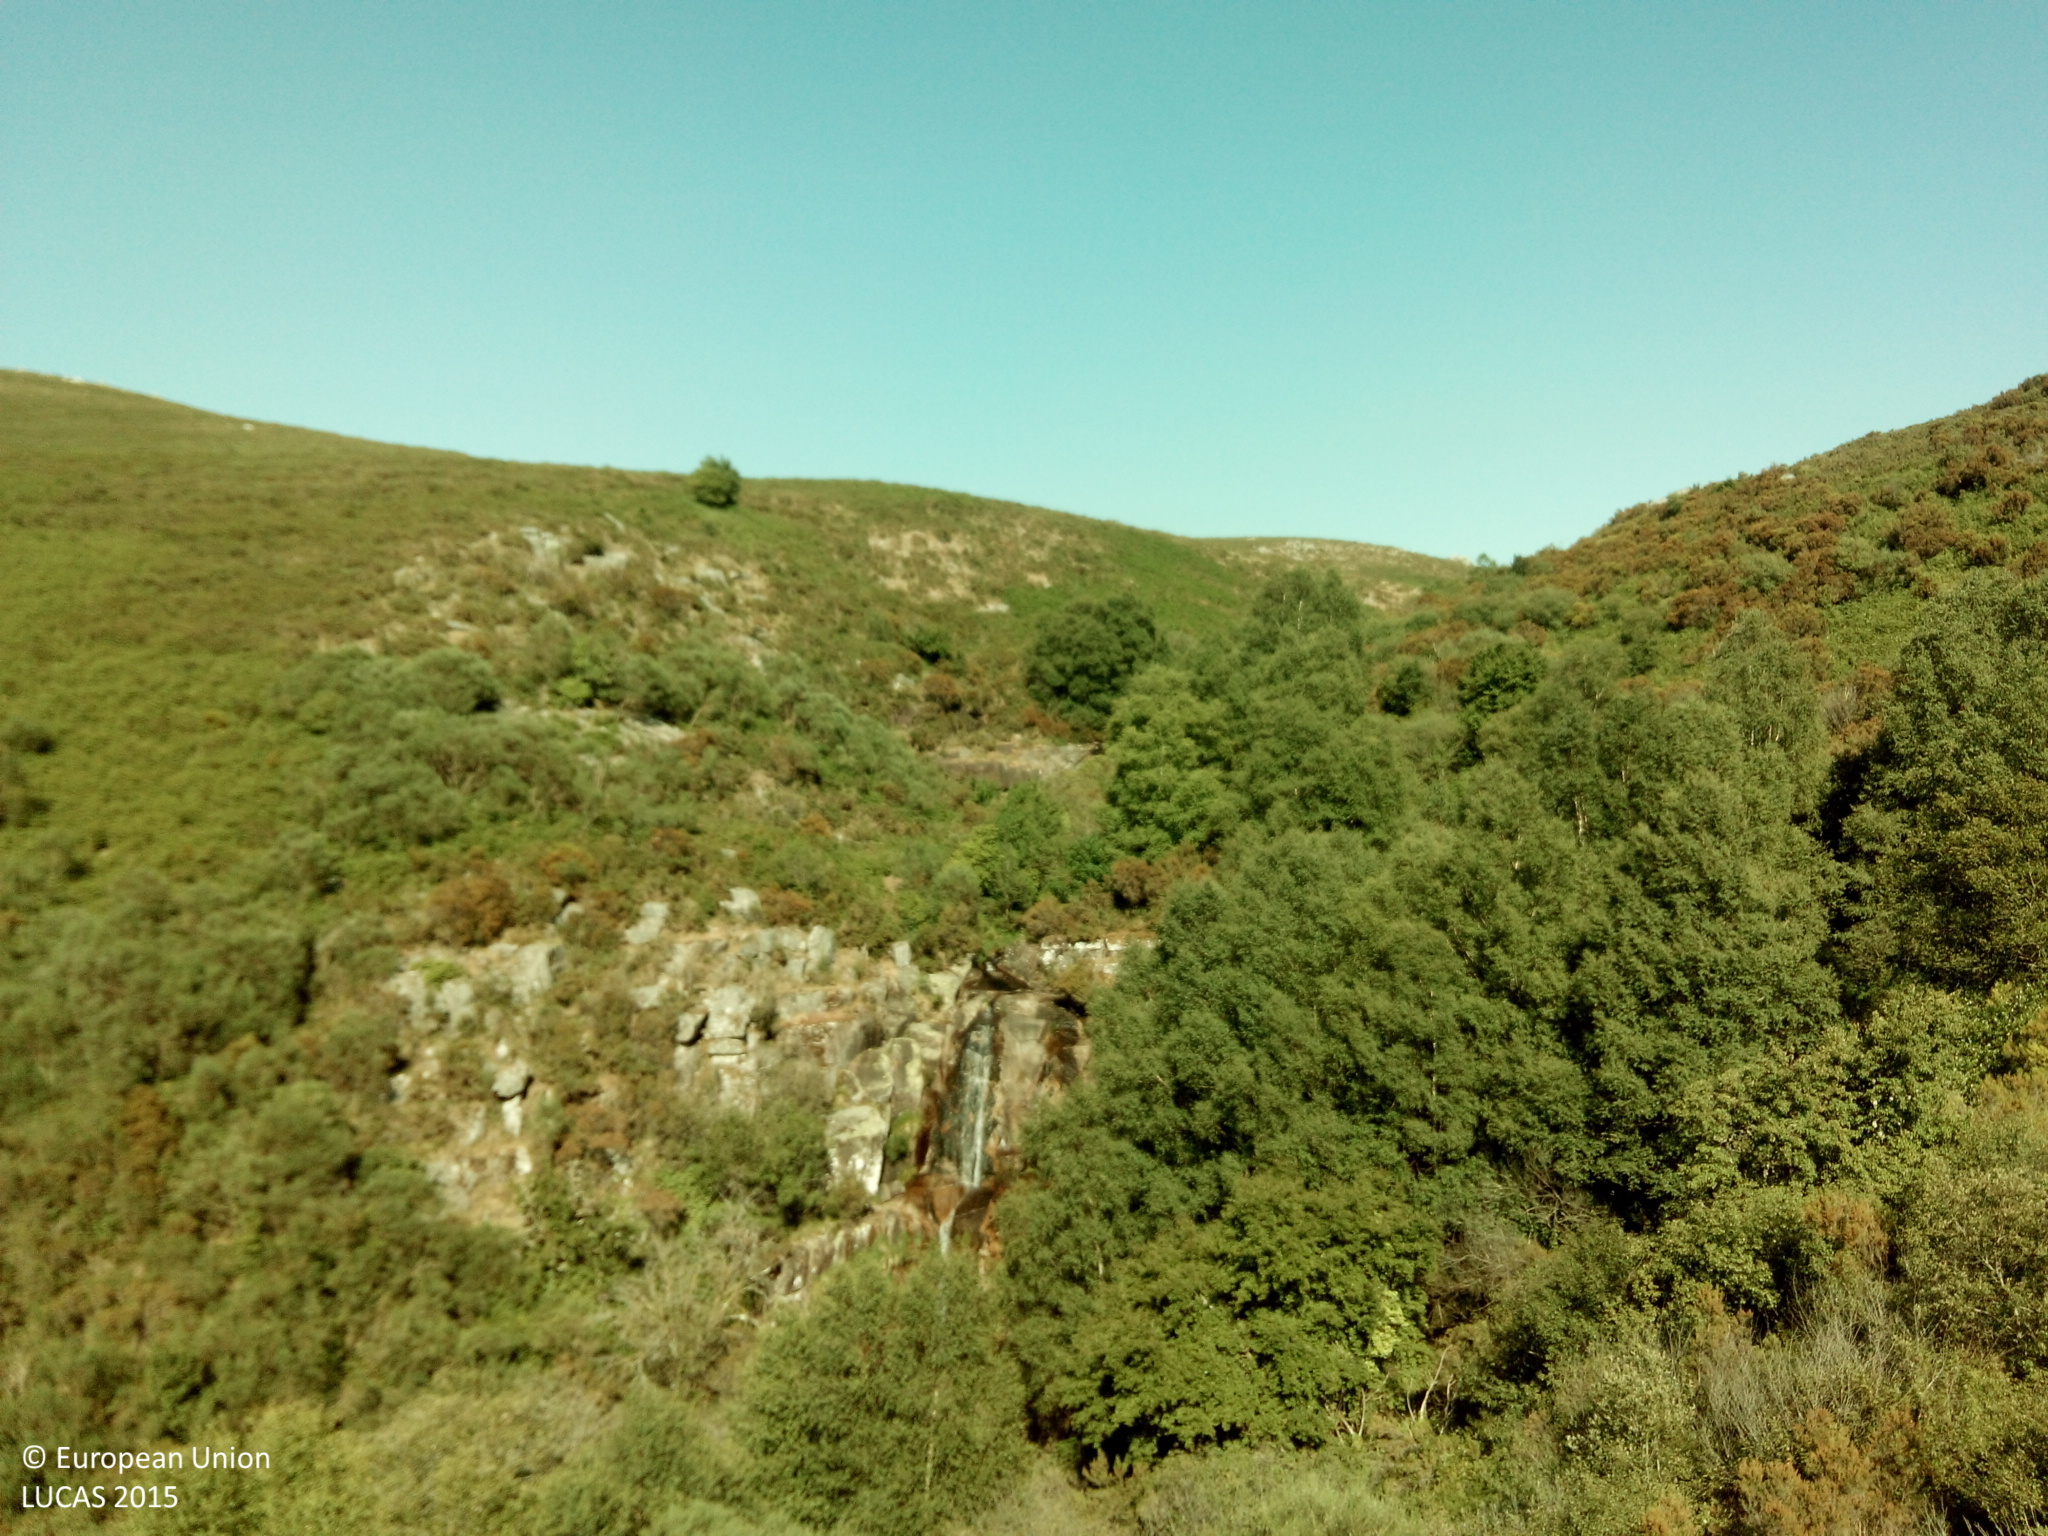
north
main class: Shrubland
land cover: Shrubland with sparse tree cover
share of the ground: > 75 %
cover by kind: shrubs 95 %, broadleaved forest trees 5 %
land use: Semi-natural and natural areas not in use
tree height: > 5 m
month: June
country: ES
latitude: 42.3440
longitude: -8.3600
